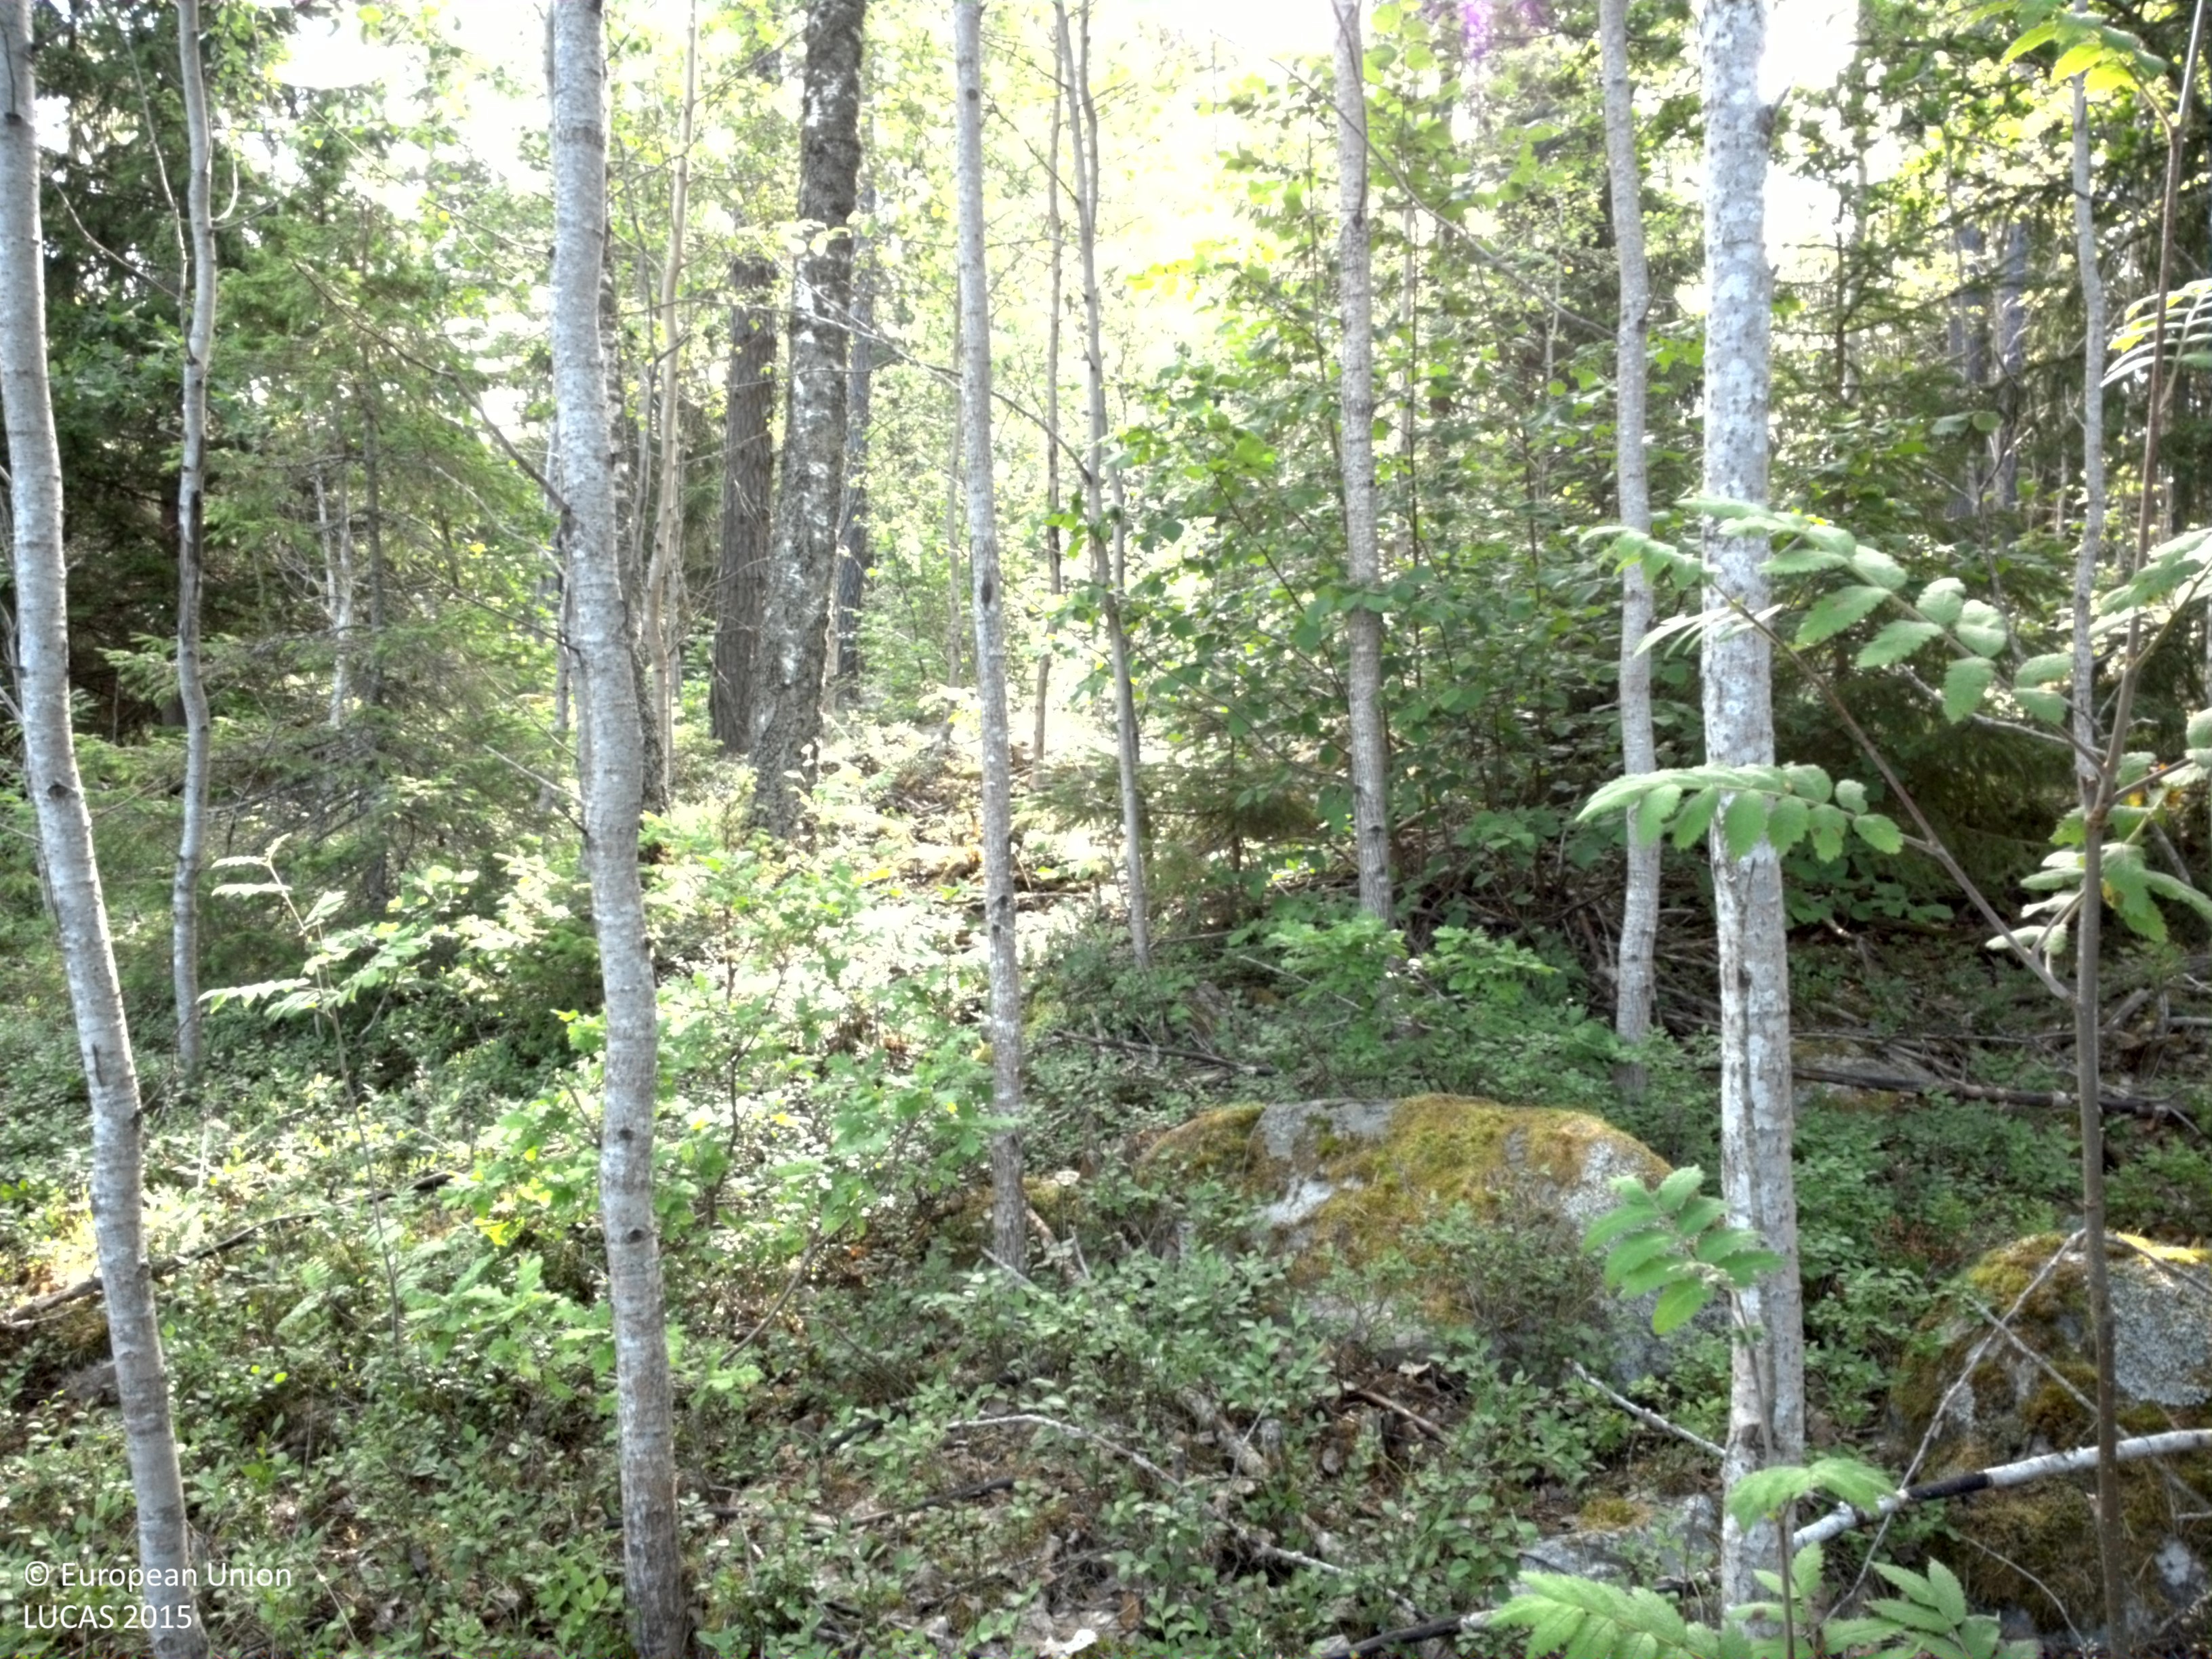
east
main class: Woodland
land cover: Pine dominated mixed woodland
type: boreal forest
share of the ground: > 75 %
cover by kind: coniferous forest trees 50 %, broadleaved forest trees 30 %, lichens and mosses 20 %
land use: Forestry
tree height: > 5 m
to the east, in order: Pine dominated mixed woodland; Pine dominated coniferous woodland; Pine dominated mixed woodland; Broadleaved woodland; Ditches and canals; Broadleaved woodland; Ditches and canals; Grass margins; Paved roads, cycling and walking lanes; Grassland without tree/shrub cover; Electric lines; Ditches and canals; Grassland without tree/shrub cover
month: July
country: SE
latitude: 59.8063
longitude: 18.6451
